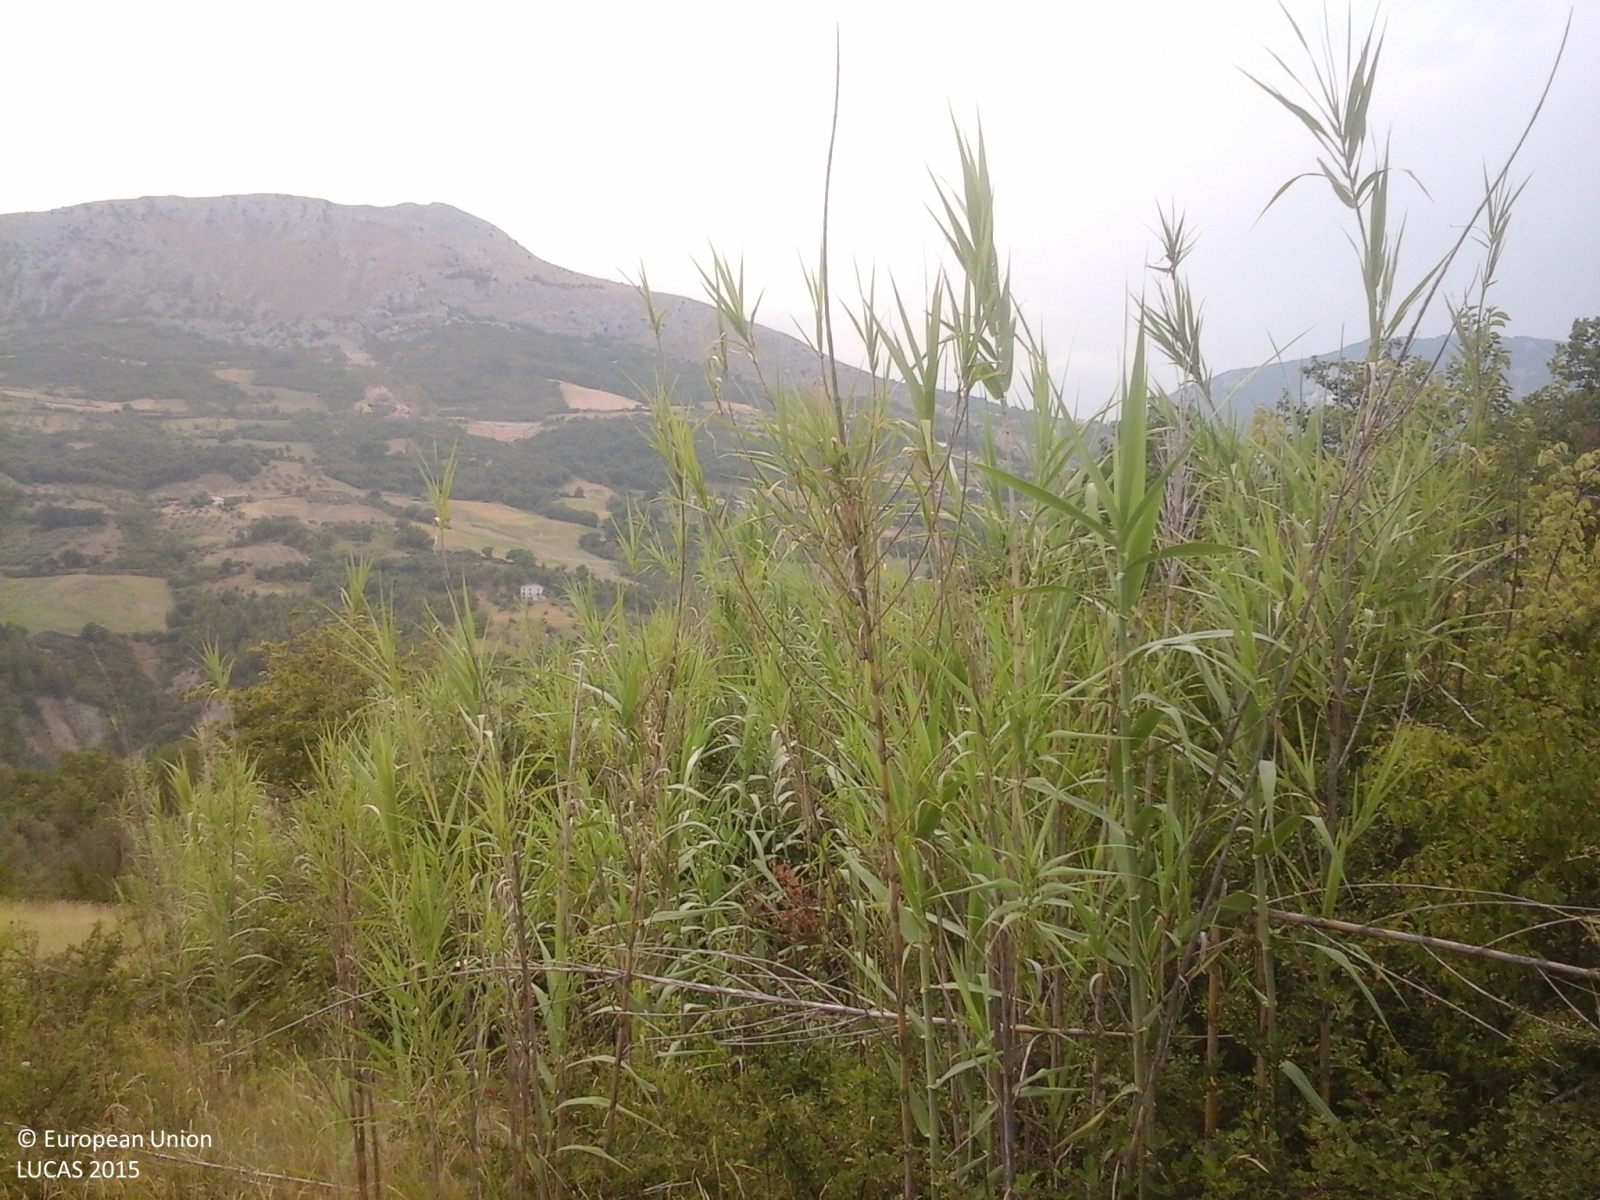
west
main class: Woodland
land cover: Broadleaved woodland
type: thermophilous deciduous forest
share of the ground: > 75 %
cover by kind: broadleaved forest trees 80 %, shrubs 10 %, herbaceous plants 10 %
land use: Semi-natural and natural areas not in use
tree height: > 5 m
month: July
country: IT
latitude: 42.2714
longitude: 13.9039
